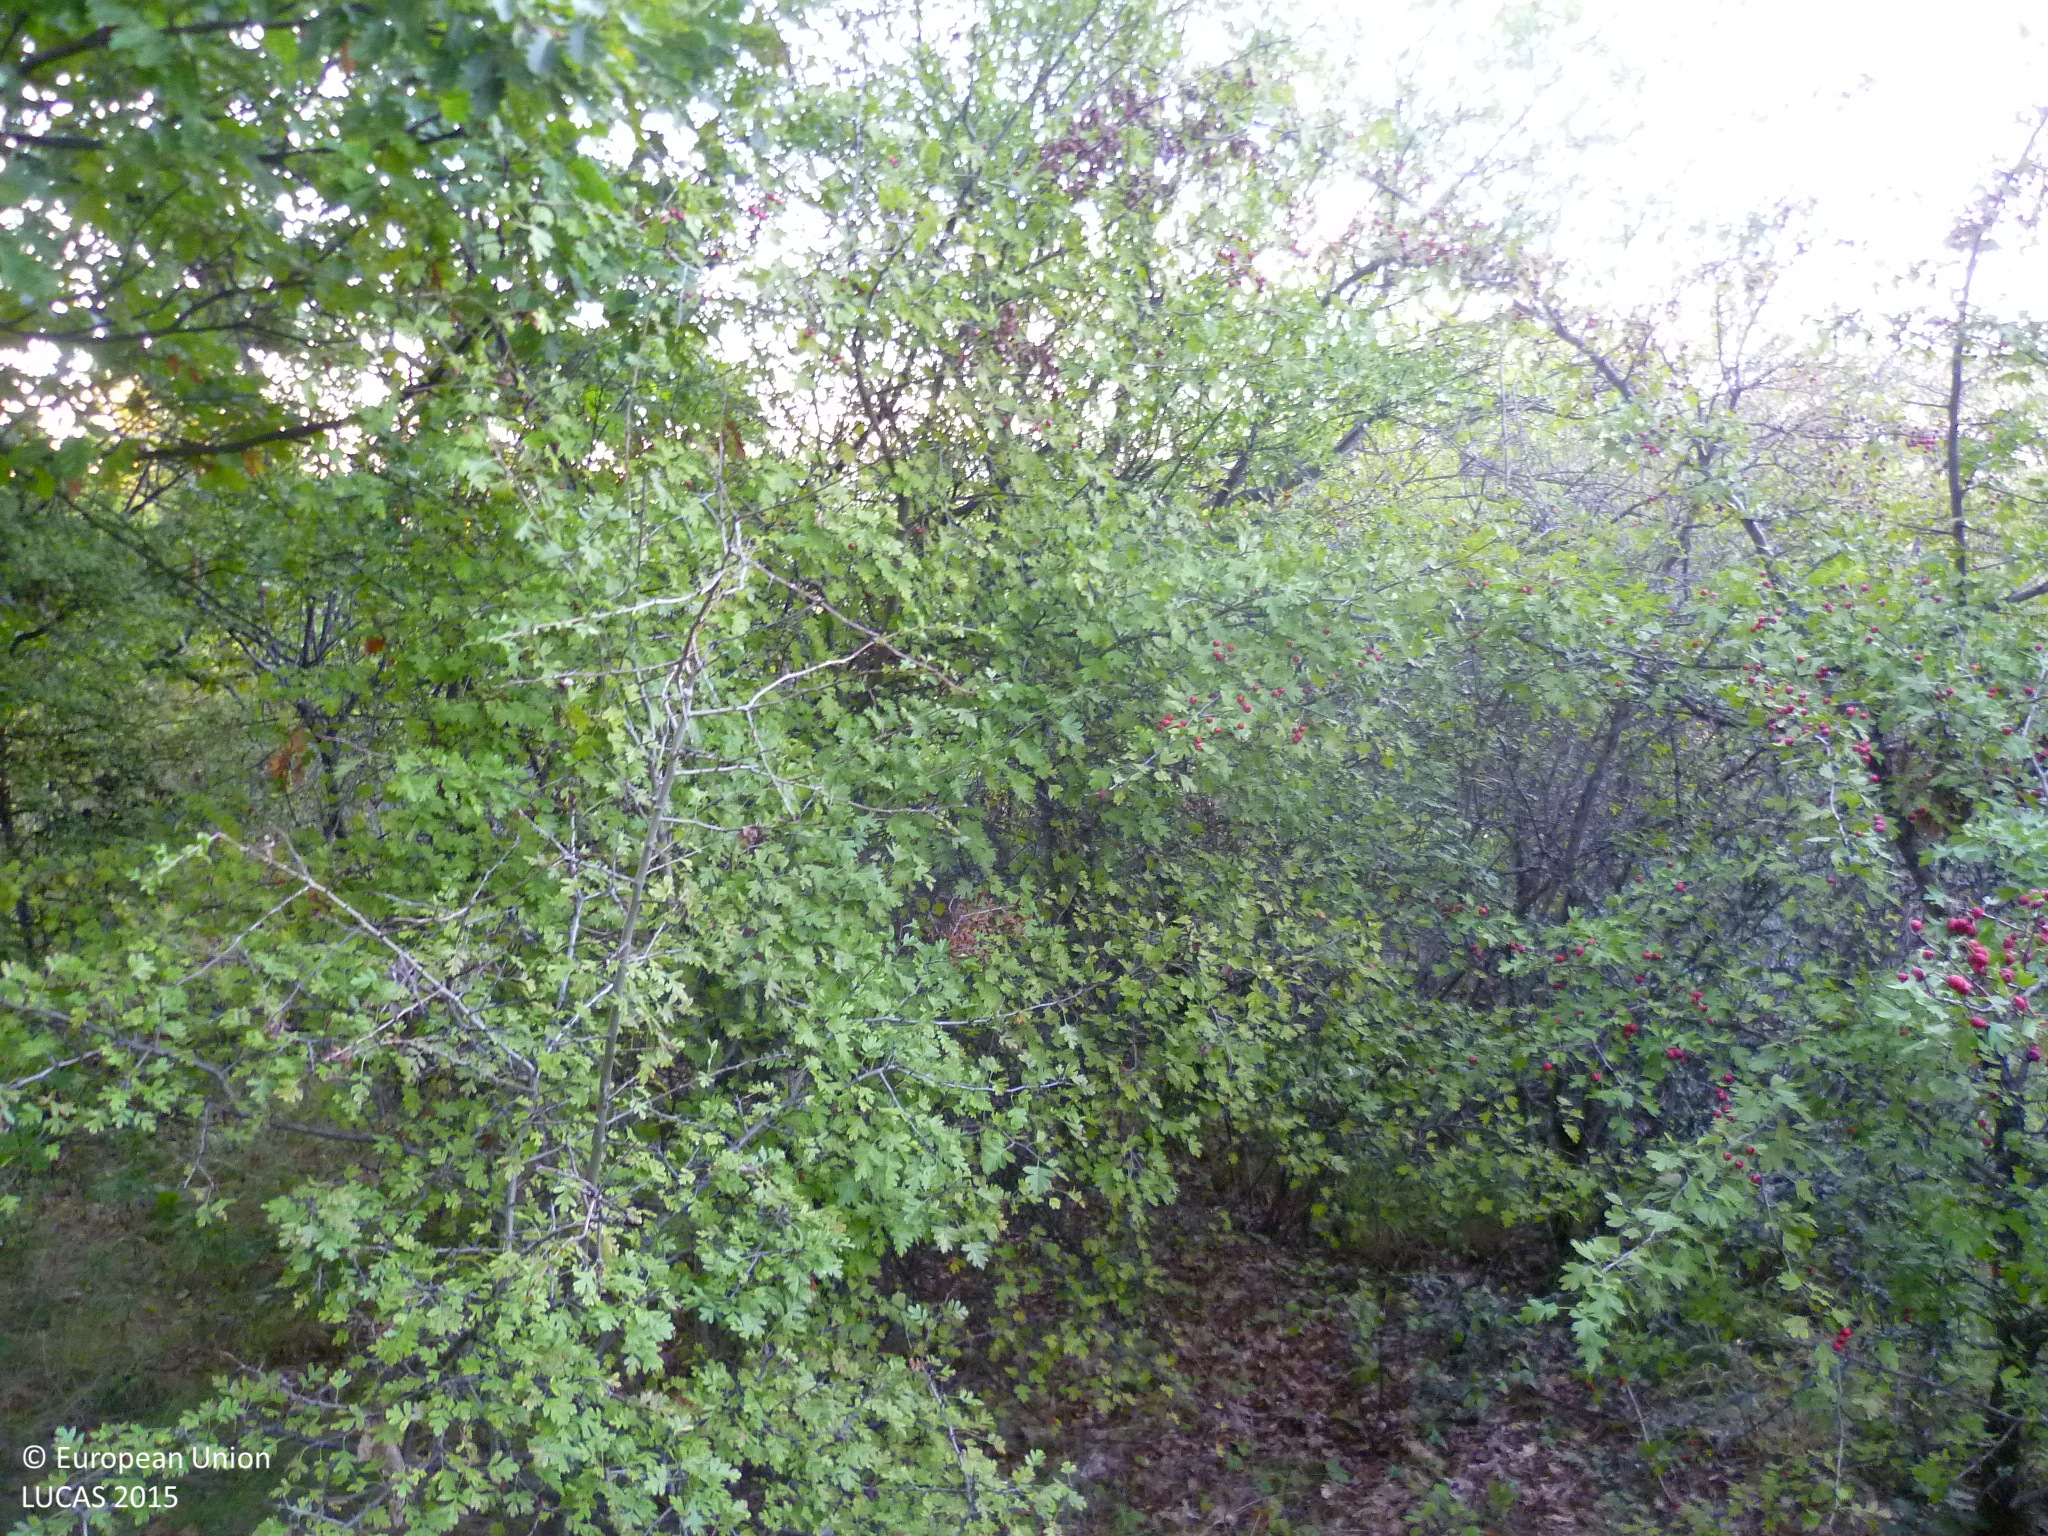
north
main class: Woodland
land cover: Broadleaved woodland
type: mesophytic deciduous forest
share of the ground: > 75 %
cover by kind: broadleaved forest trees 55 %, shrubs 30 %, herbaceous plants 15 %
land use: Semi-natural and natural areas not in use
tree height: > 5 m
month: October
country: BG
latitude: 43.0121
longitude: 22.9017
